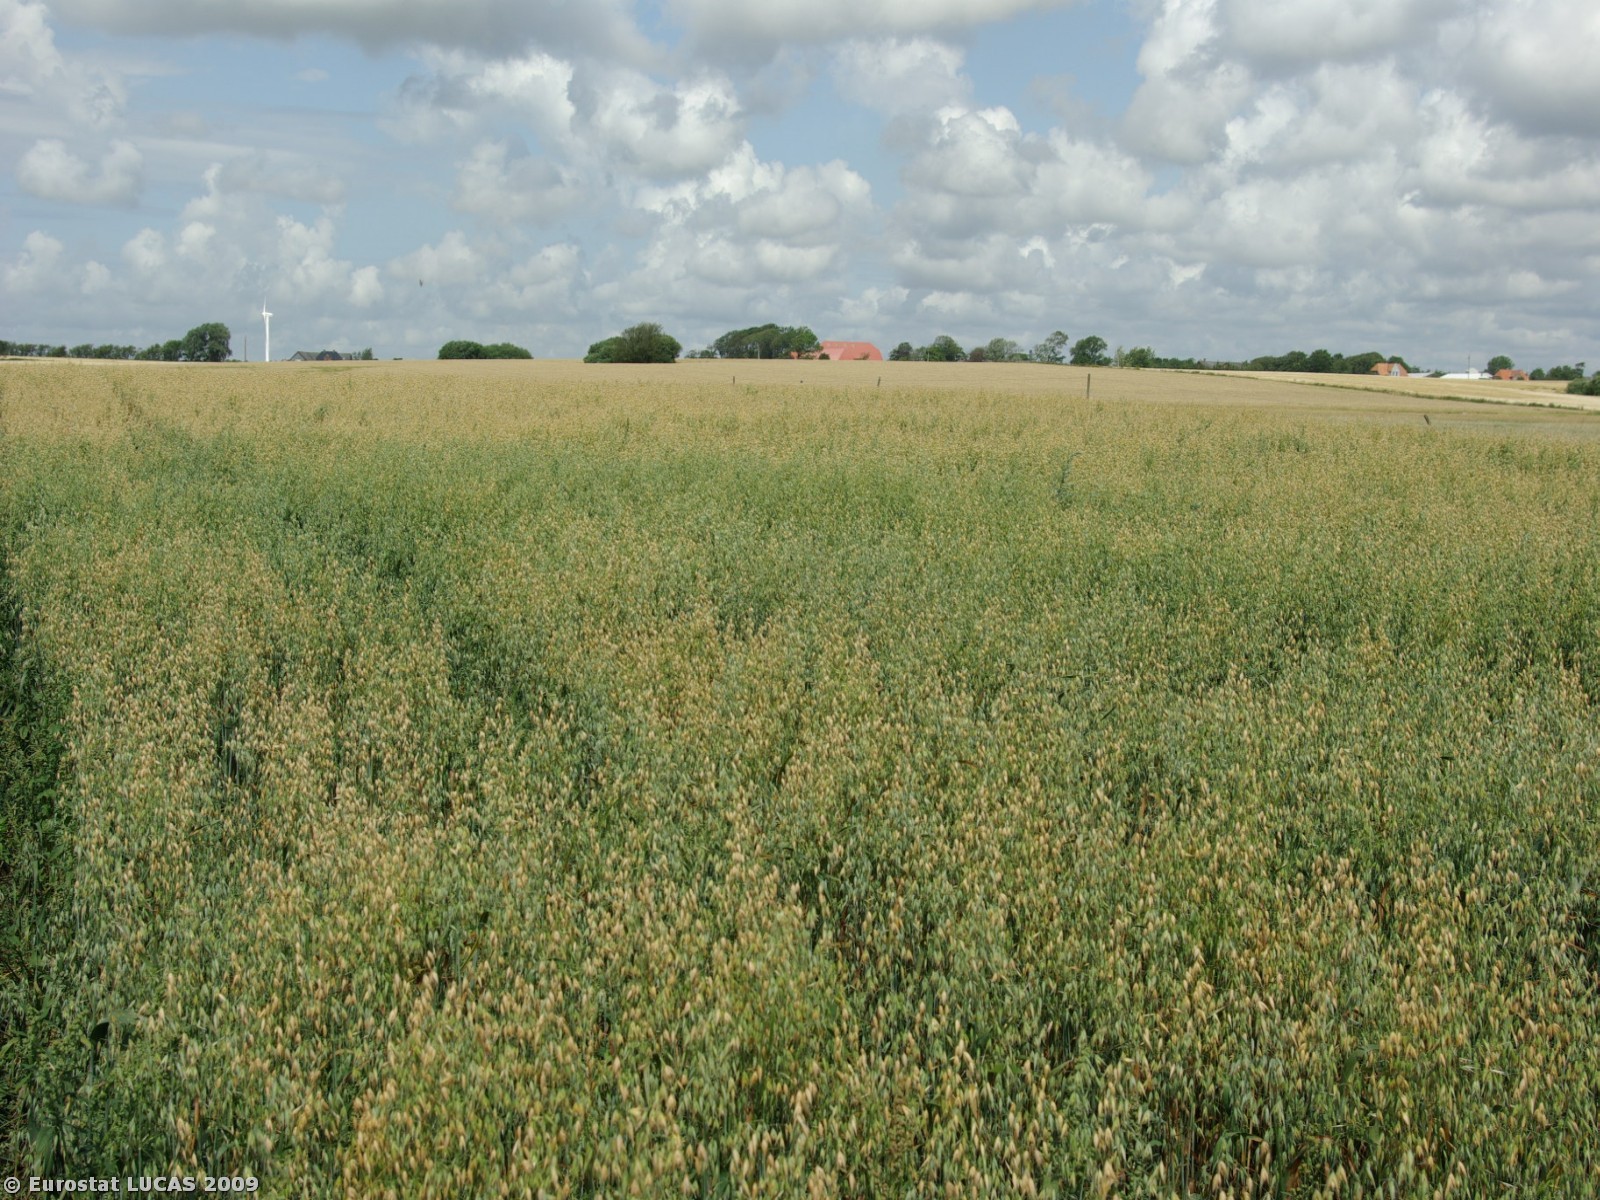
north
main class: Cropland
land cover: Oats
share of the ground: > 75 %
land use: Agriculture (excluding fallow land and kitchen gardens)
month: July
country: DK
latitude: 55.0316
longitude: 8.7962
